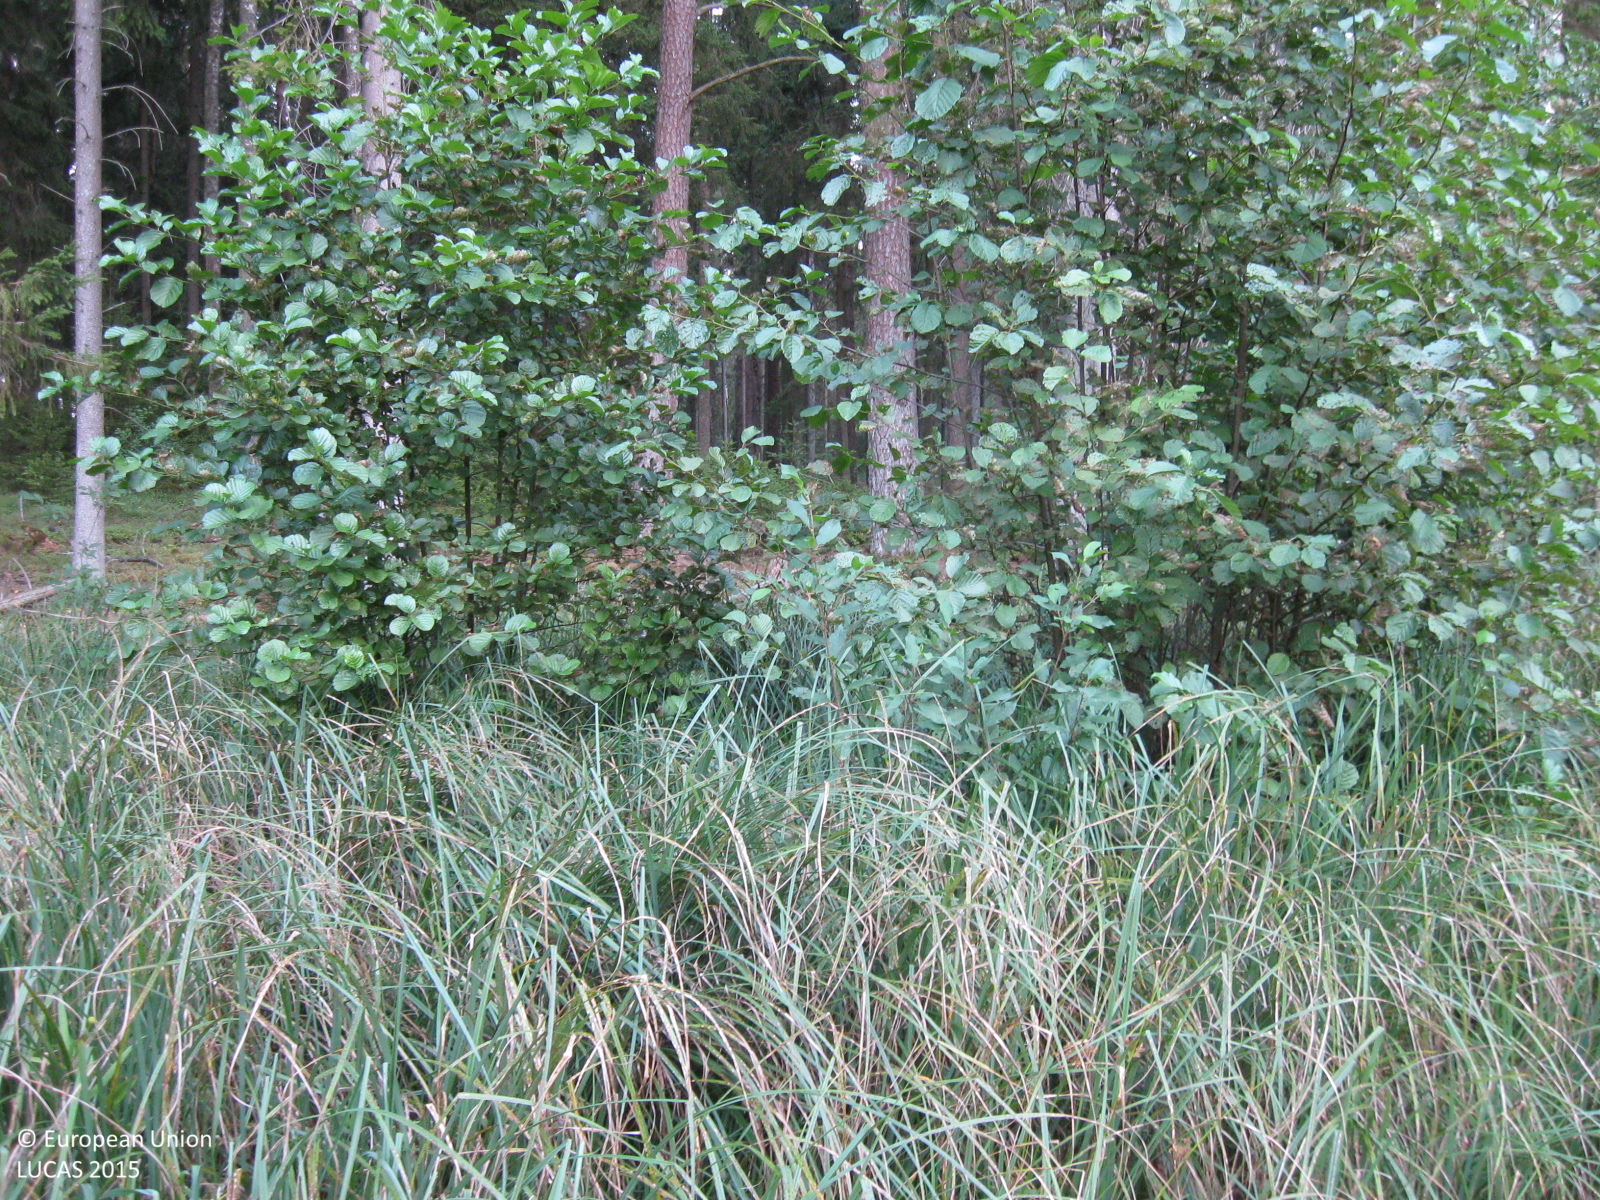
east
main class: Woodland
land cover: Broadleaved woodland
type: mire and swamp forests
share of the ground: 50 - 75 %
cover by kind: herbaceous plants 50 %, broadleaved forest trees 40 %, coniferous forest trees 10 %
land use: Forestry
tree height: < 5 m
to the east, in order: Broadleaved woodland; Other mixed woodland; Spruce dominated coniferous woodland; Other mixed woodland; Spruce dominated coniferous woodland
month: August
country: LT
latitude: 55.3341
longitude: 22.8846
